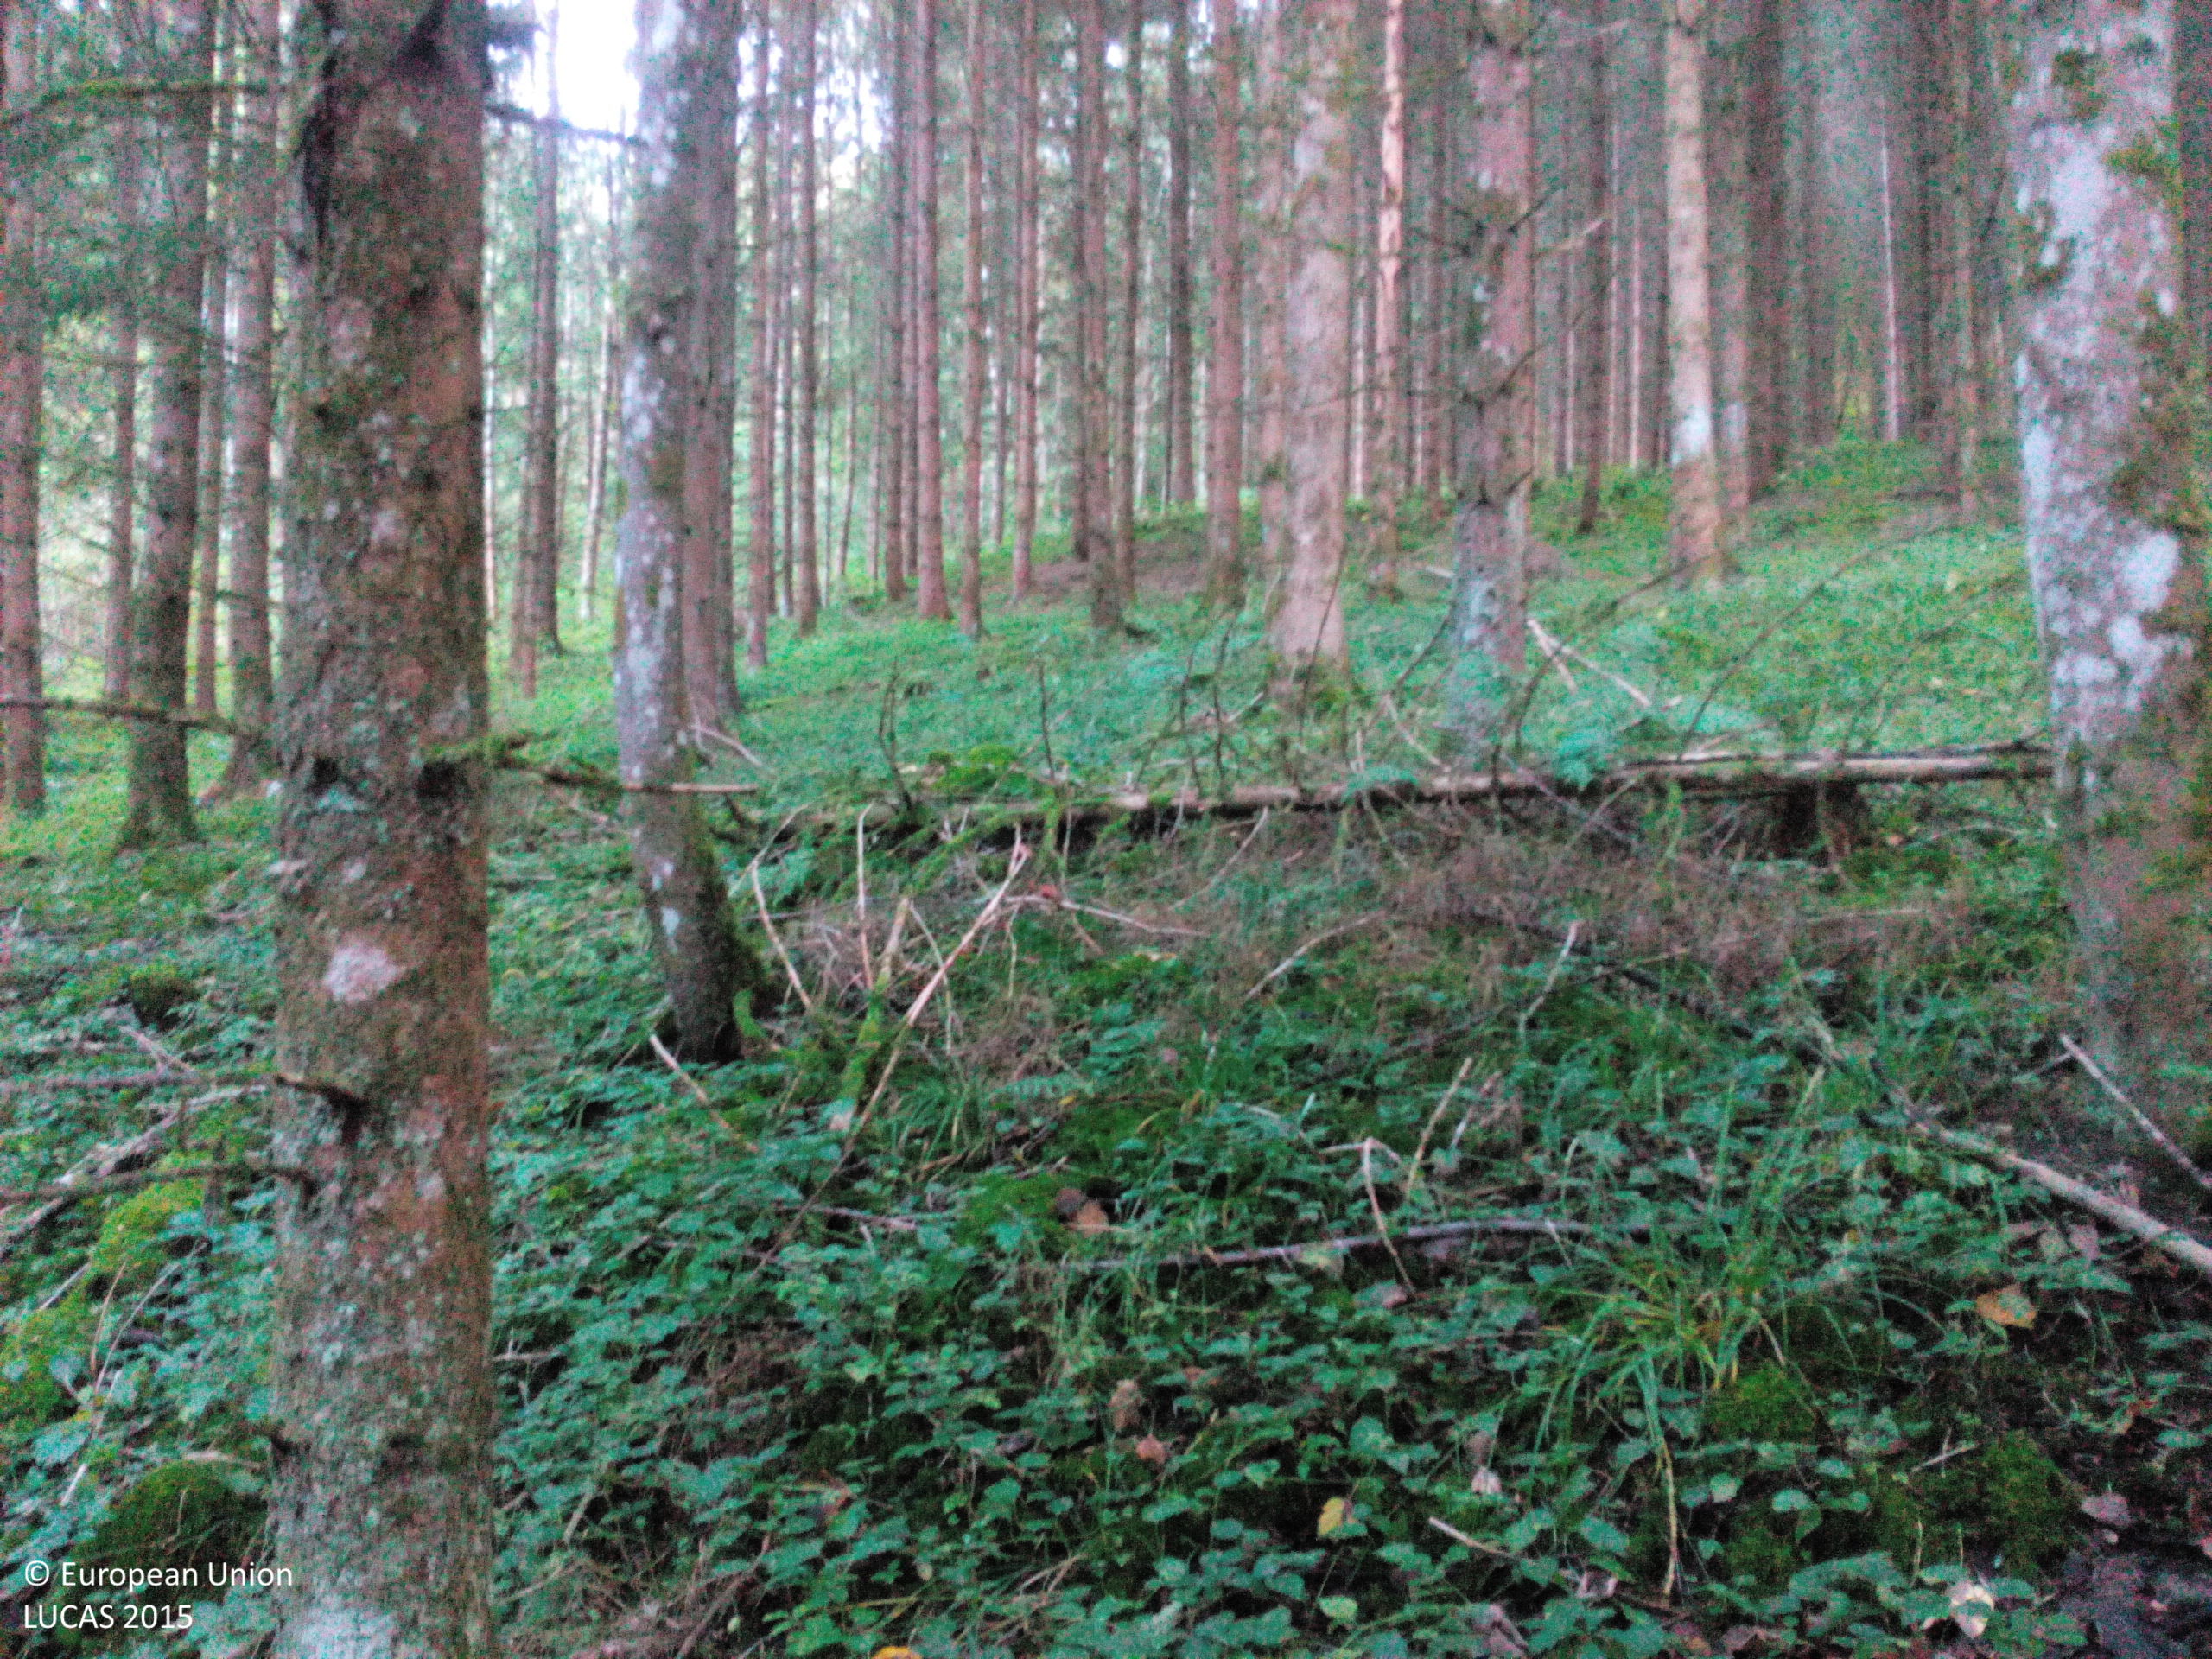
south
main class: Woodland
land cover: Other mixed woodland
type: hemiboreal forest and nemoral coniferous forest and mixed broadleaved-coniferous forest
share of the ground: > 75 %
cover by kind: broadleaved forest trees 60 %, coniferous forest trees 30 %, herbaceous plants 5 %, consolidated bare surface 5 %
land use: Forestry
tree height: > 5 m
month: September
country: DE
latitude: 48.5397
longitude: 8.6868
